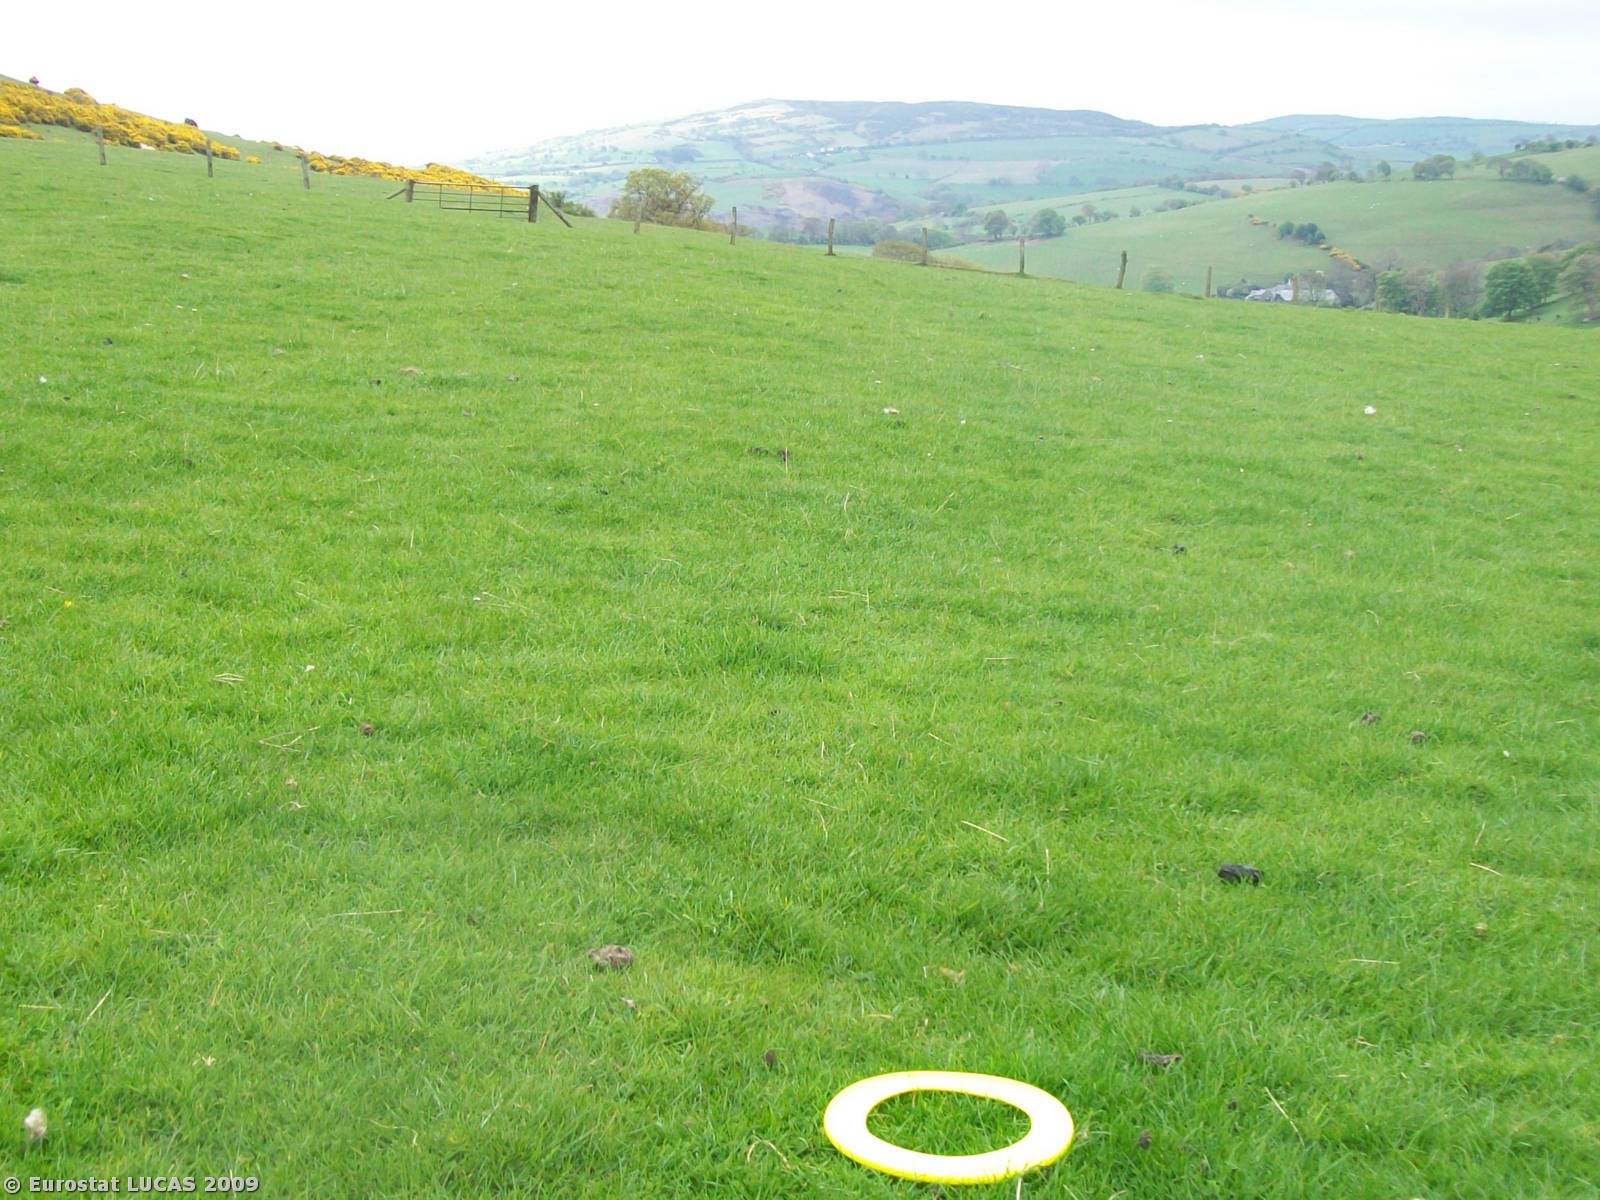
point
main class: Grassland
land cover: Grassland without tree/shrub cover
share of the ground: > 75 %
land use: Agriculture (excluding fallow land and kitchen gardens)
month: April
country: GB
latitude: 53.1701
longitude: -3.5027
